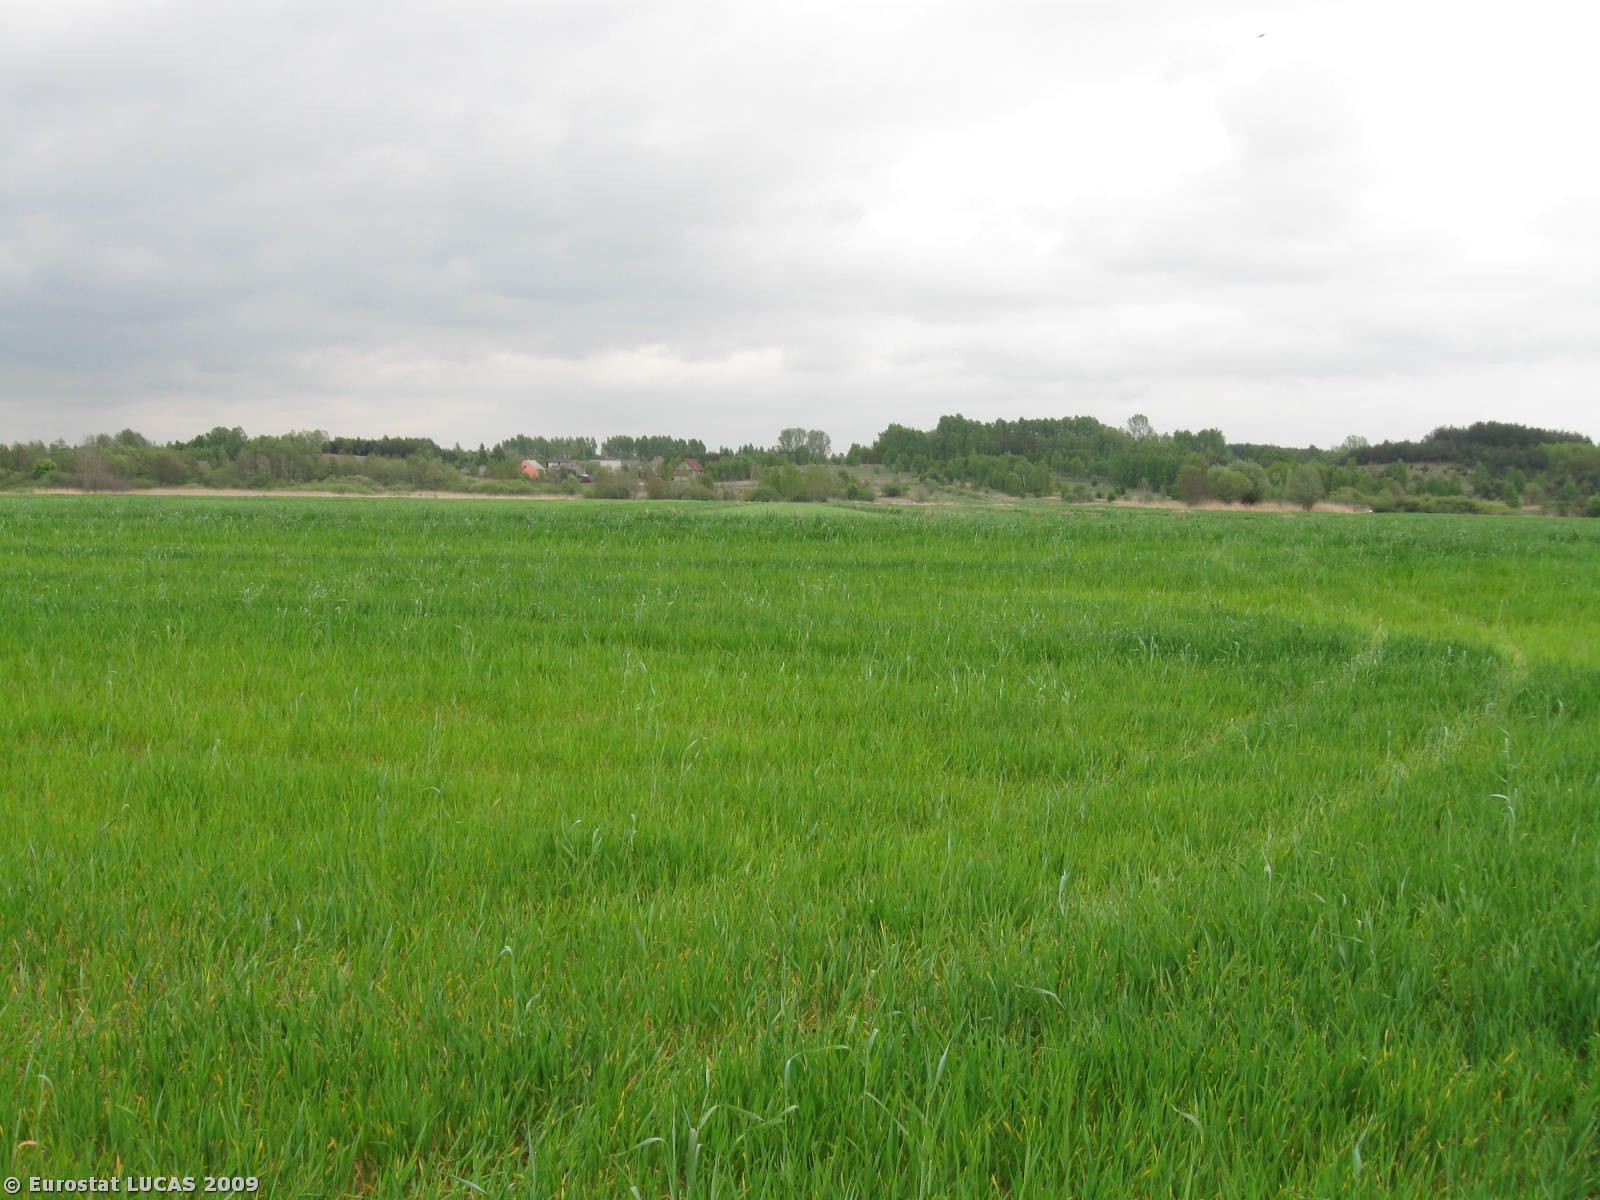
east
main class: Cropland
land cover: Rye
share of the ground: > 75 %
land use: Agriculture (excluding fallow land and kitchen gardens)
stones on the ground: < 10 %
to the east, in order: Rye; Common wheat; Grass margins; Common wheat; Grassland without tree/shrub cover; Potatoes; Common wheat; Potatoes; Grassland without tree/shrub cover; Sugar beet
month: May
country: PL
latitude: 50.9455
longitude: 21.3067
